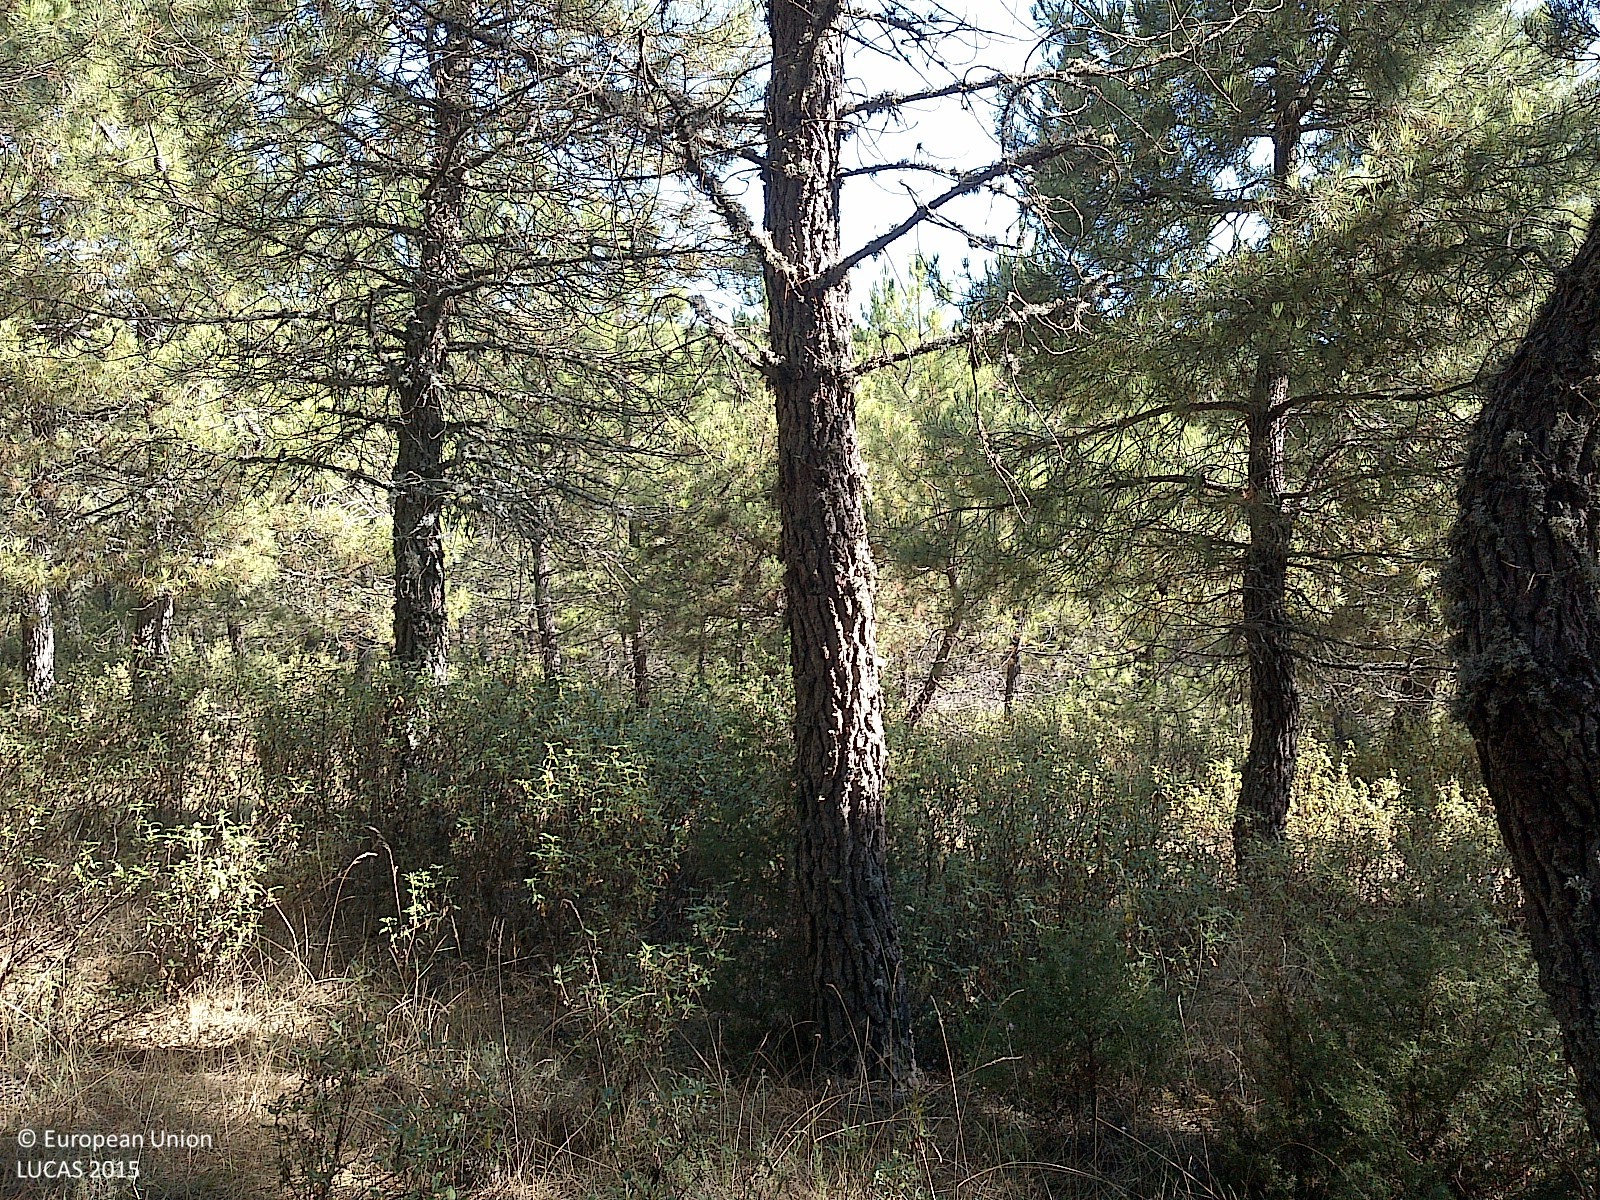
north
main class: Woodland
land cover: Pine dominated coniferous woodland
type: coniferous forest of the mediterranean region
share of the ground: > 75 %
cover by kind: coniferous forest trees 85 %, shrubs 10 %, lichens and mosses 5 %
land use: Forestry
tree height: > 5 m
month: July
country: ES
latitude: 41.7746
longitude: -3.1476
